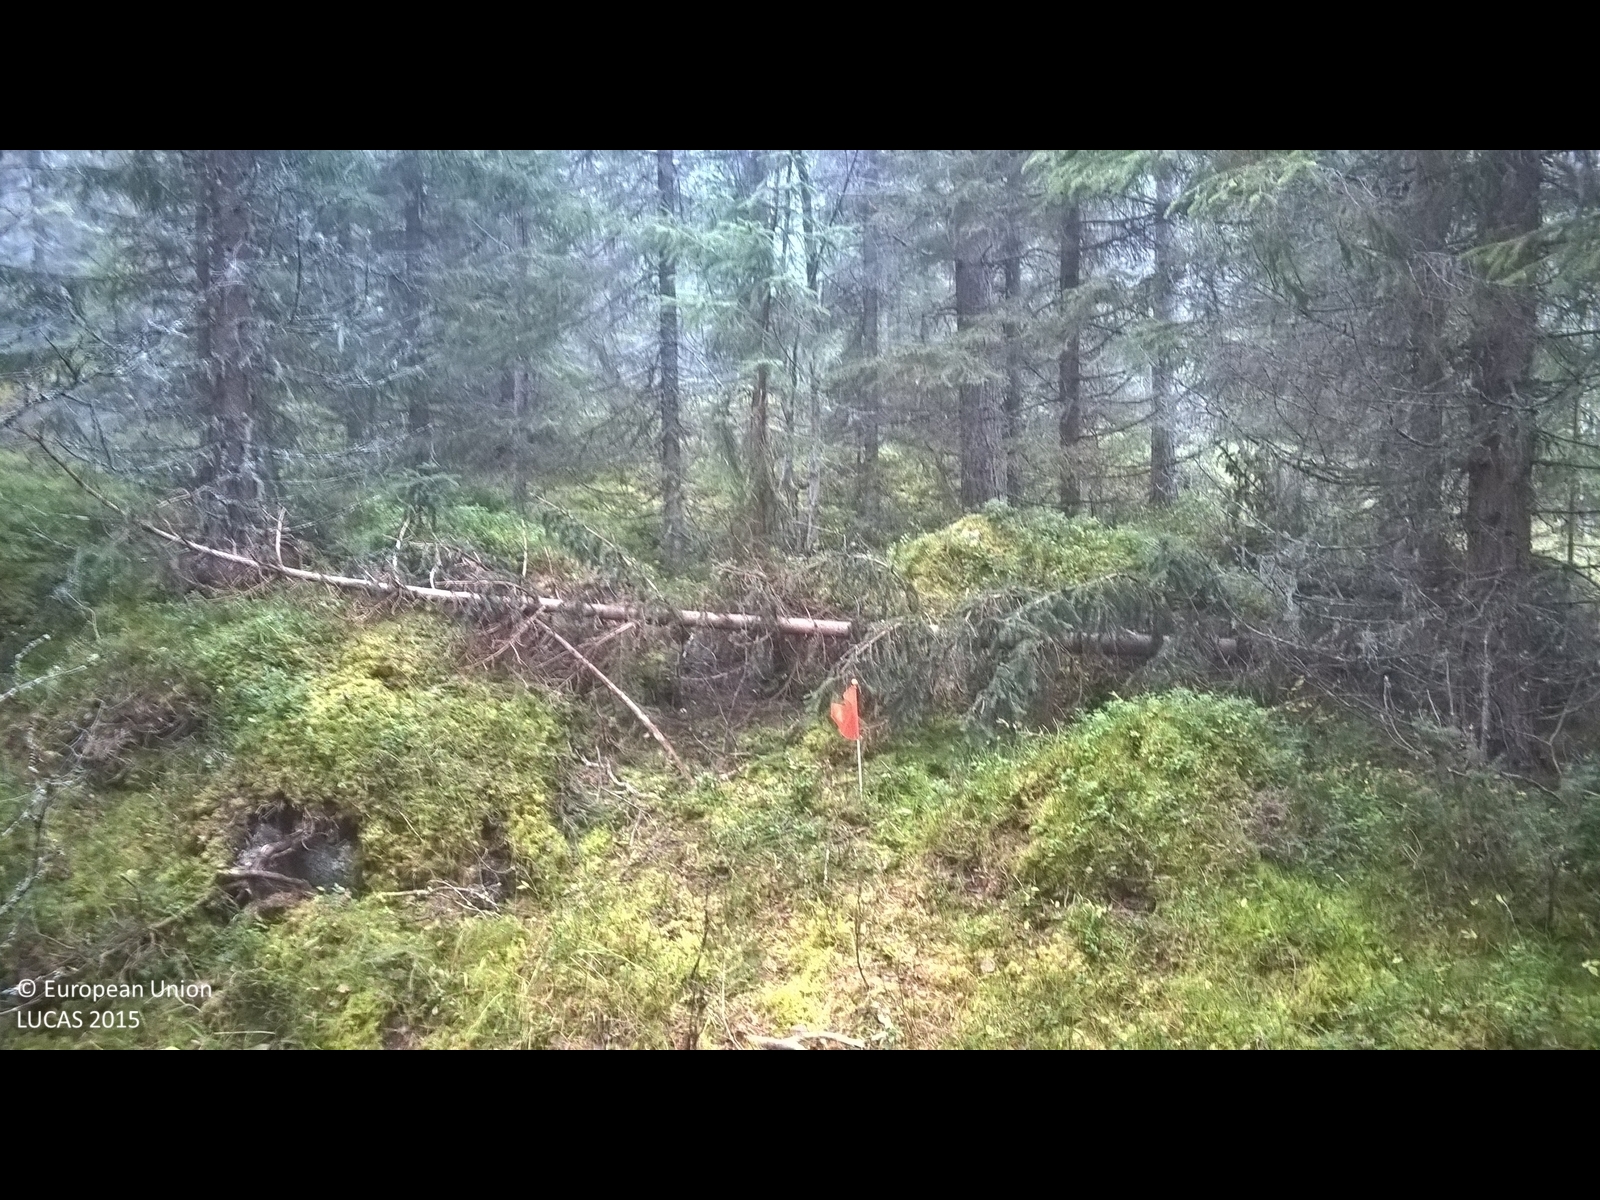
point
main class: Woodland
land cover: Spruce dominated coniferous woodland
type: boreal forest
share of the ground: > 75 %
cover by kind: coniferous forest trees 85 %, lichens and mosses 15 %
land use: Forestry
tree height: > 5 m
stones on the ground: < 10 %
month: October
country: SE
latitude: 62.9461
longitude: 14.9648
